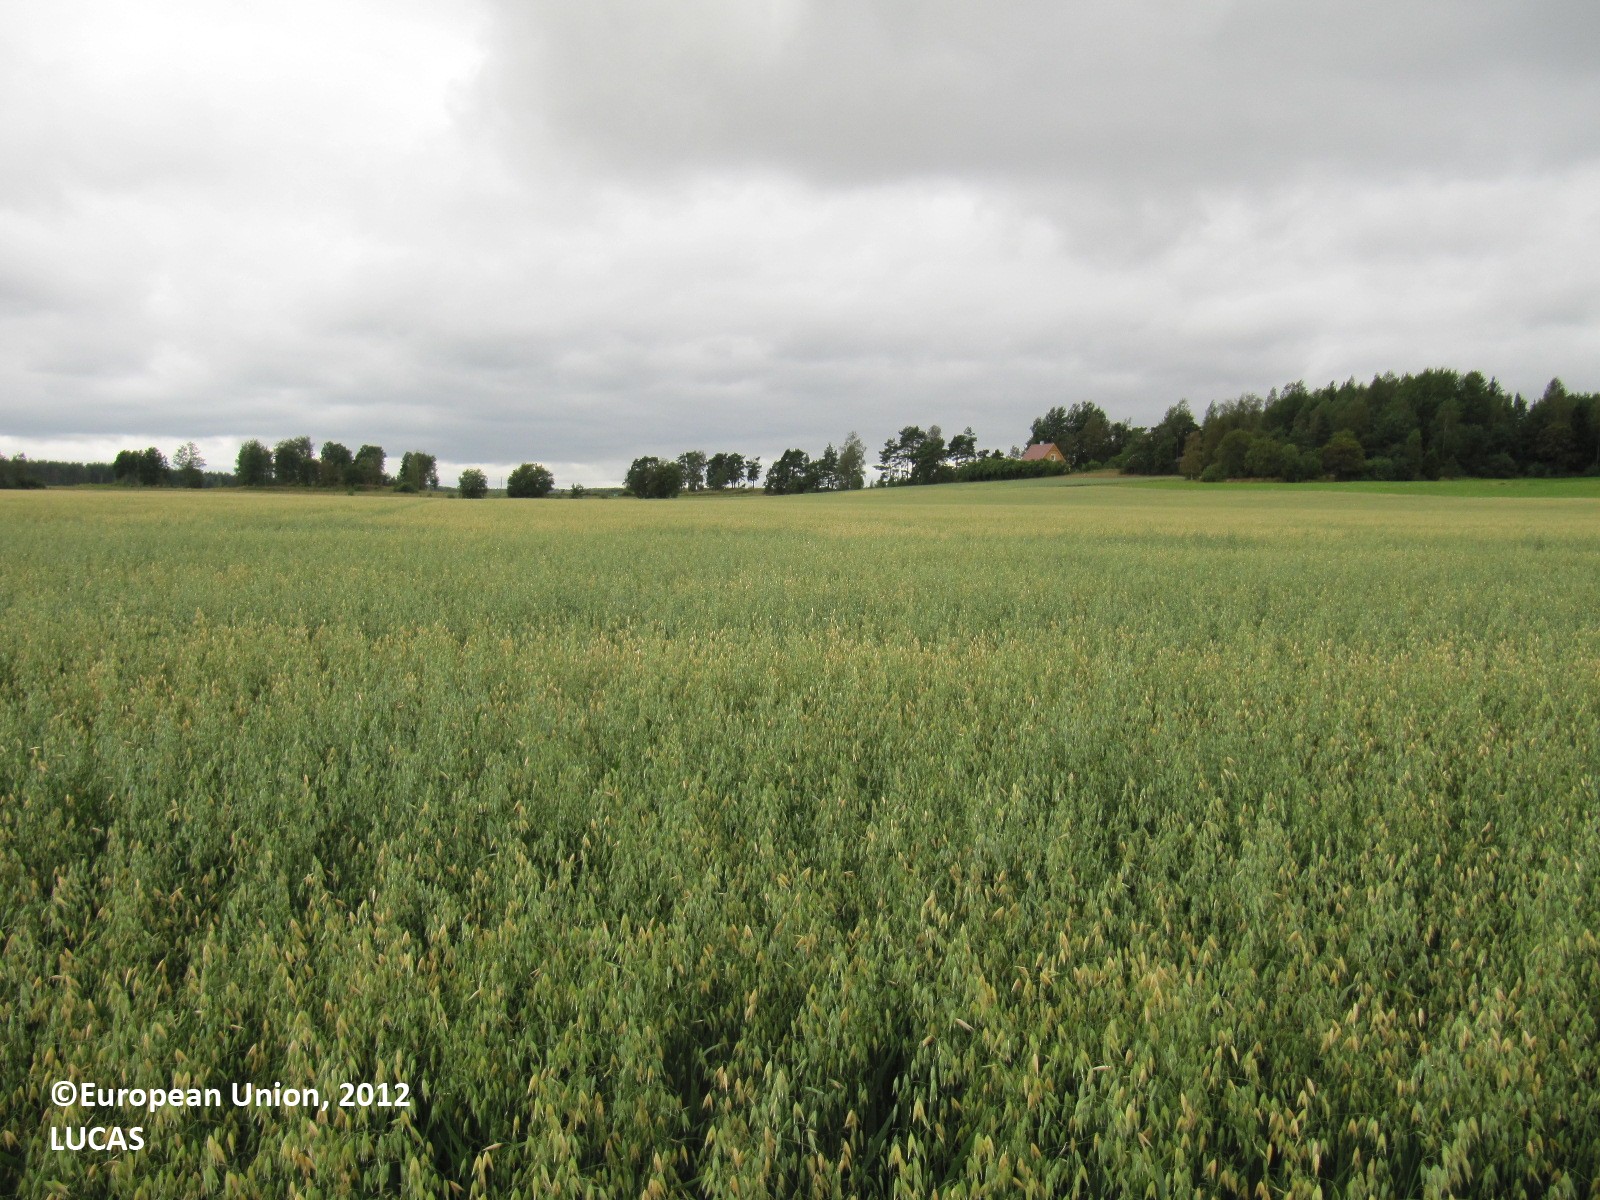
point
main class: Cropland
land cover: Oats
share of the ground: > 75 %
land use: Agriculture (excluding fallow land and kitchen gardens)
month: August
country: FI
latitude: 60.1785
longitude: 23.0059
